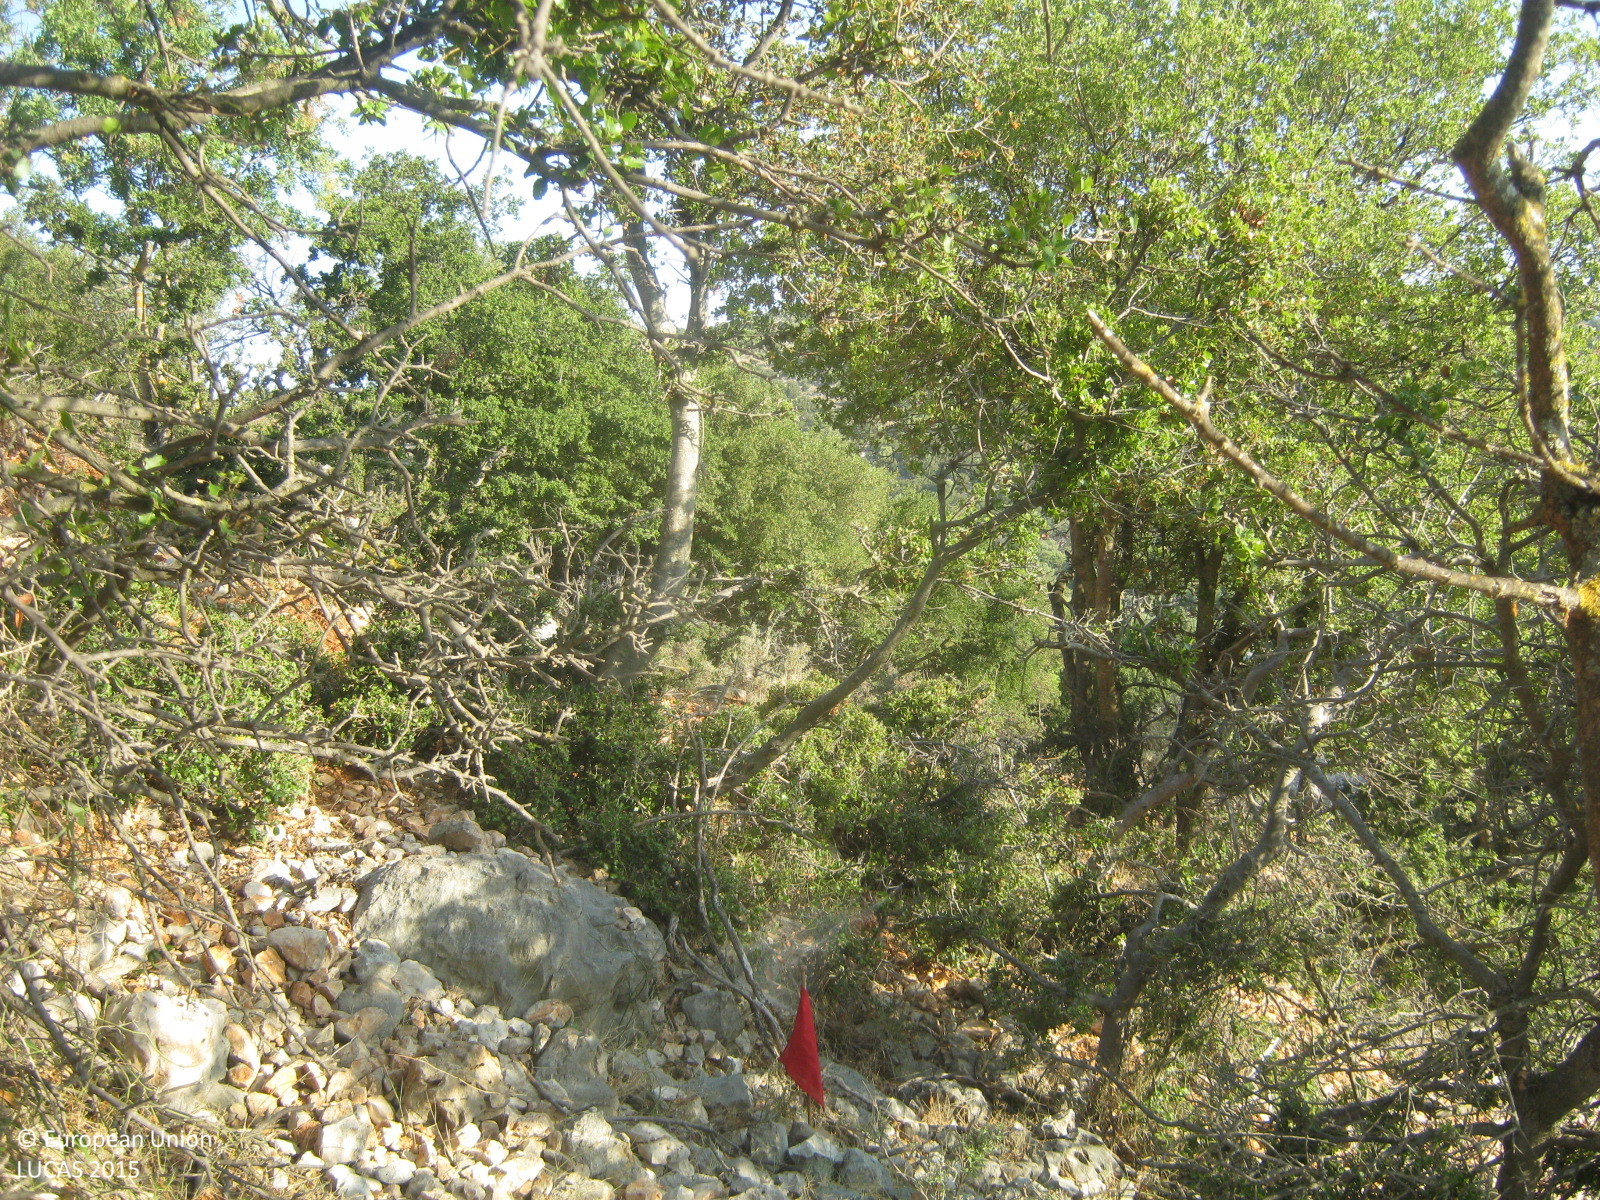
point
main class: Shrubland
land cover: Shrubland with sparse tree cover
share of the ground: > 75 %
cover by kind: shrubs 85 %, herbaceous plants 10 %, broadleaved forest trees 5 %
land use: Agriculture (excluding fallow land and kitchen gardens)
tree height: < 5 m
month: August
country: GR
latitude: 38.2058
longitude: 20.5018
